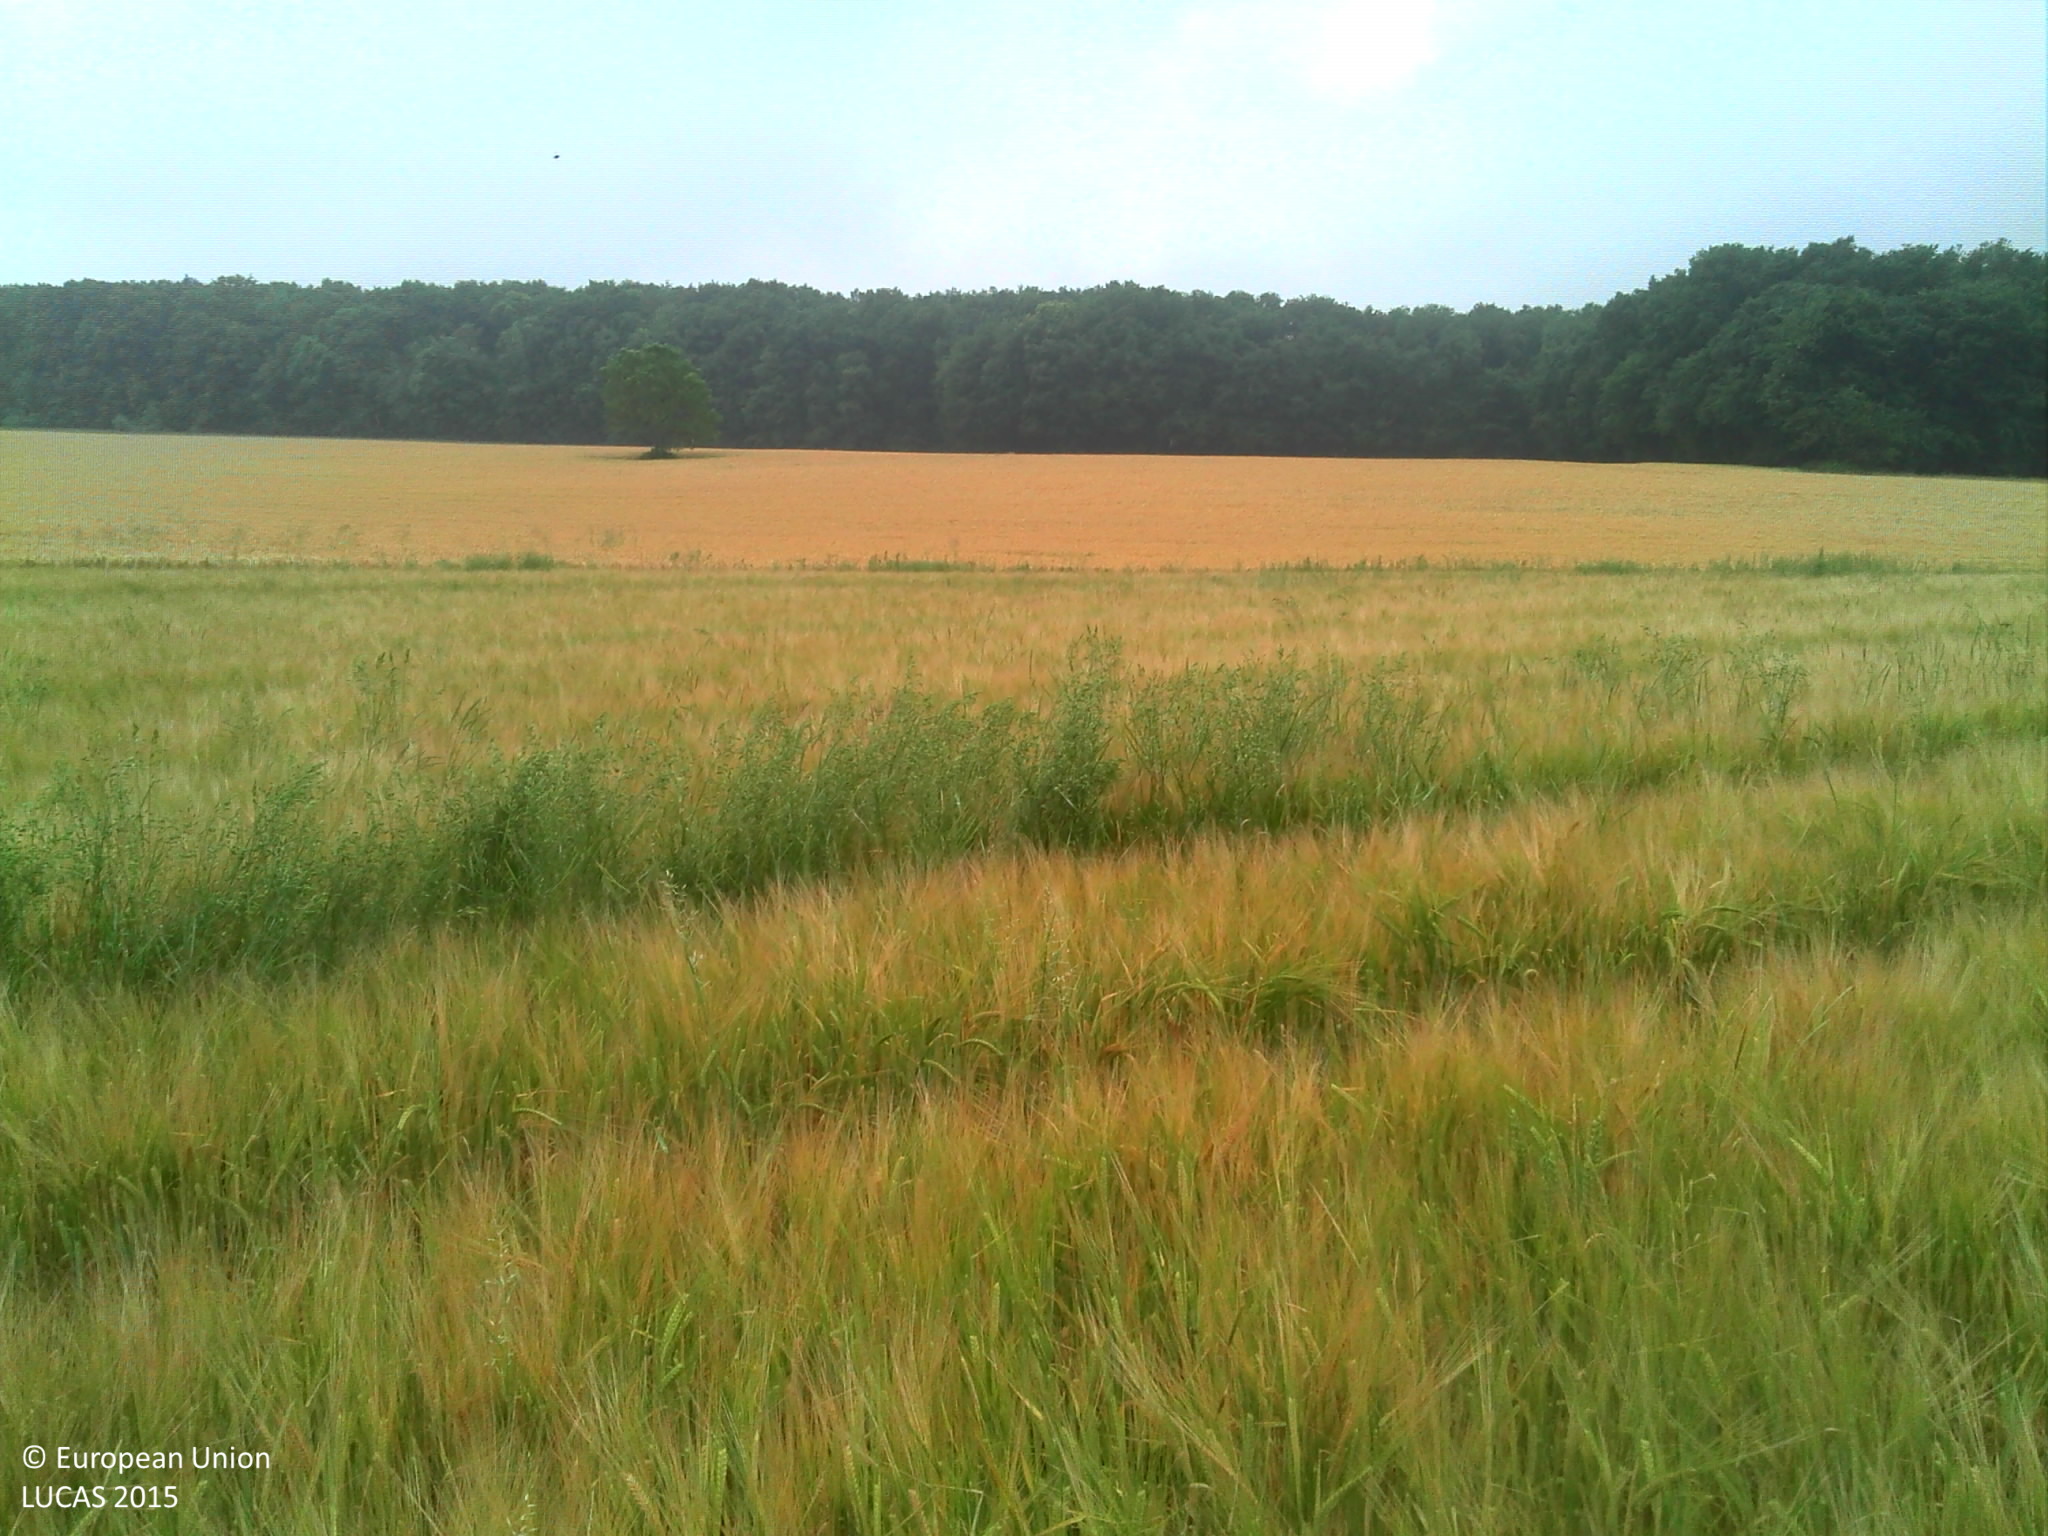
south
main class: Cropland
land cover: Barley
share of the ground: > 75 %
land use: Agriculture (excluding fallow land and kitchen gardens)
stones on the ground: < 10 %
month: June
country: FR
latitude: 47.2902
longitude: 3.1859
